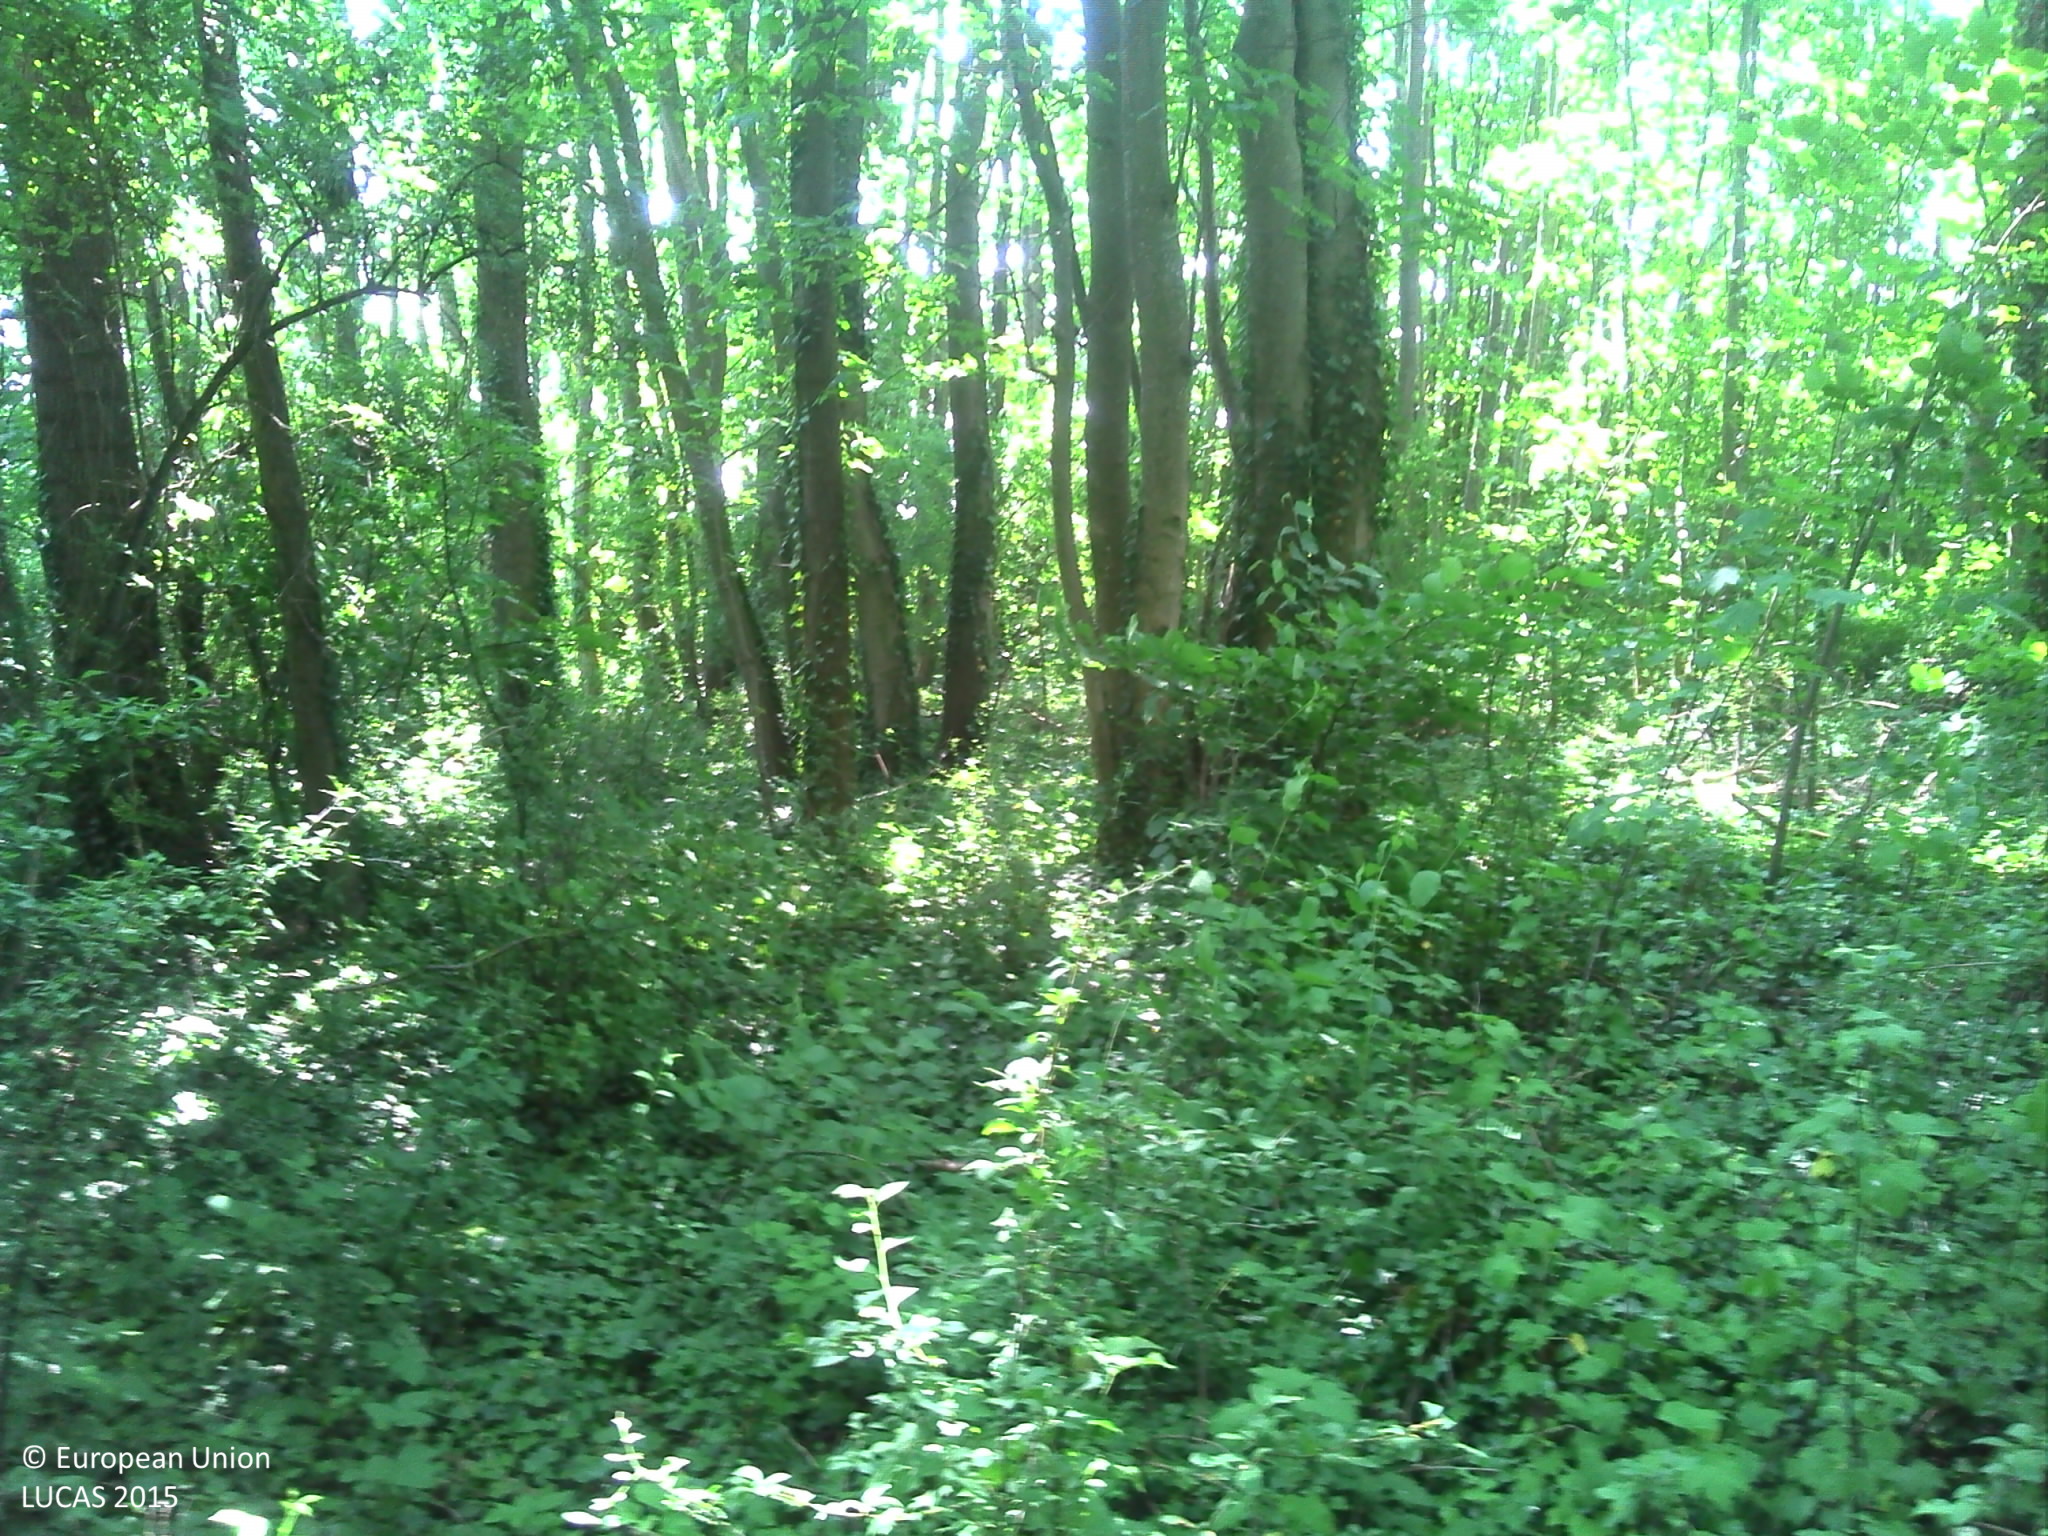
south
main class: Woodland
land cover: Broadleaved woodland
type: mesophytic deciduous forest
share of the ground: > 75 %
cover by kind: broadleaved forest trees 90 %, shrubs 5 %, herbaceous plants 5 %
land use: Semi-natural and natural areas not in use
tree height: > 5 m
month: June
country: FR
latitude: 49.5608
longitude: 4.0639
